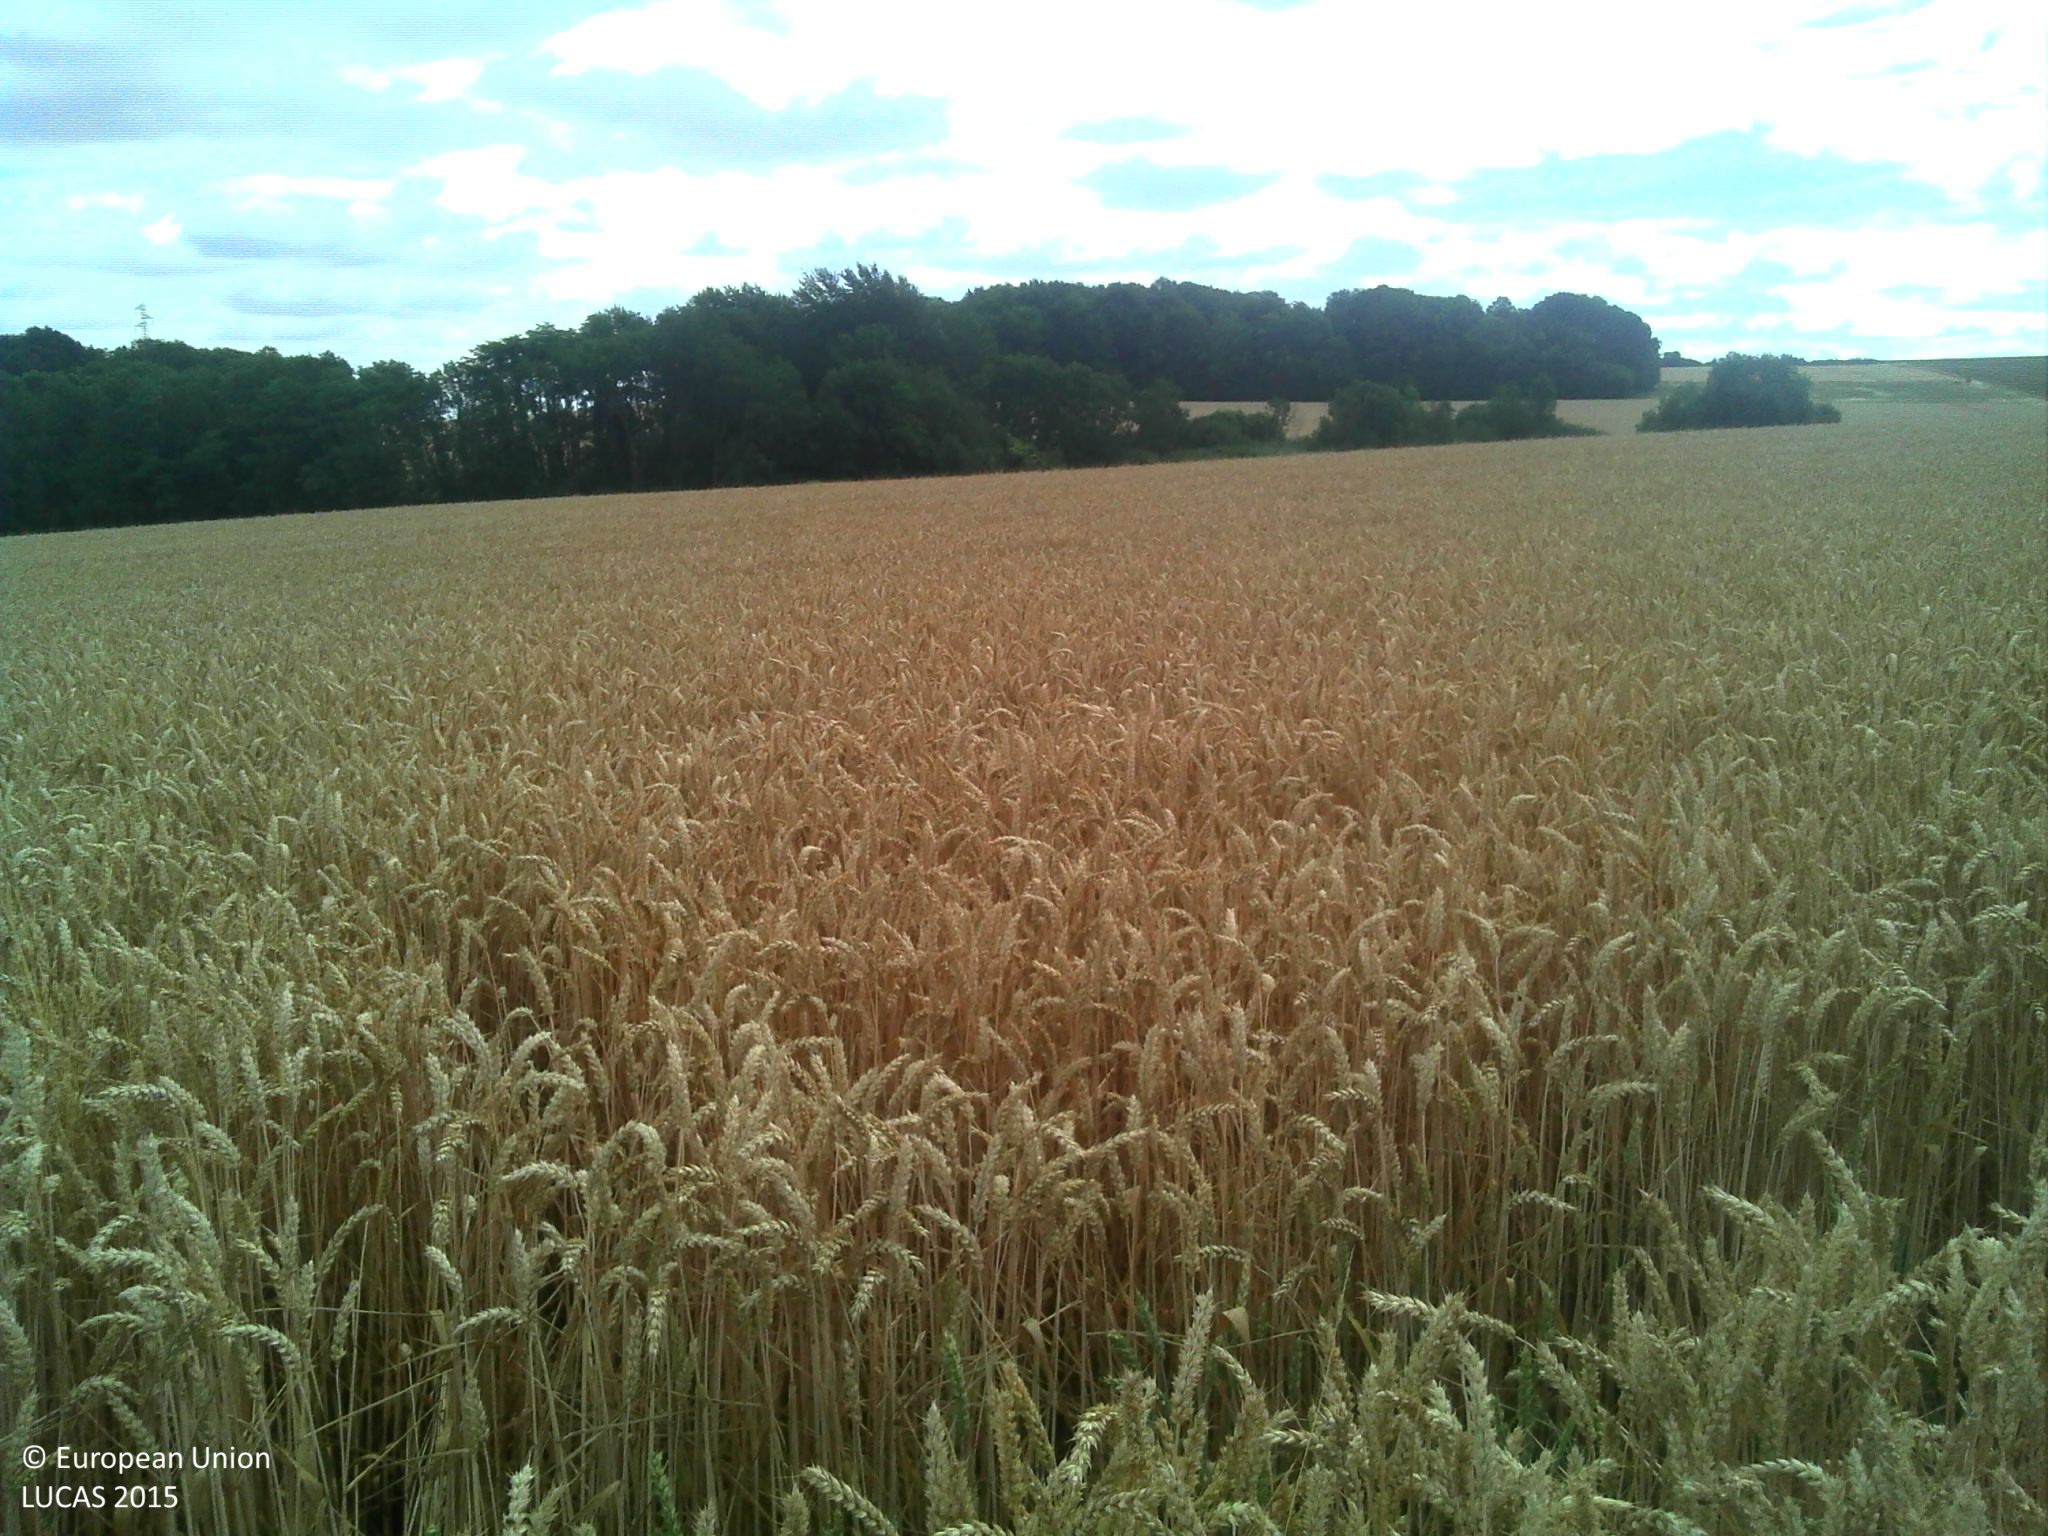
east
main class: Cropland
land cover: Common wheat
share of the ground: > 75 %
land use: Agriculture (excluding fallow land and kitchen gardens)
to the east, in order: Common wheat; Broadleaved woodland
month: July
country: FR
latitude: 49.2636
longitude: 3.2724
